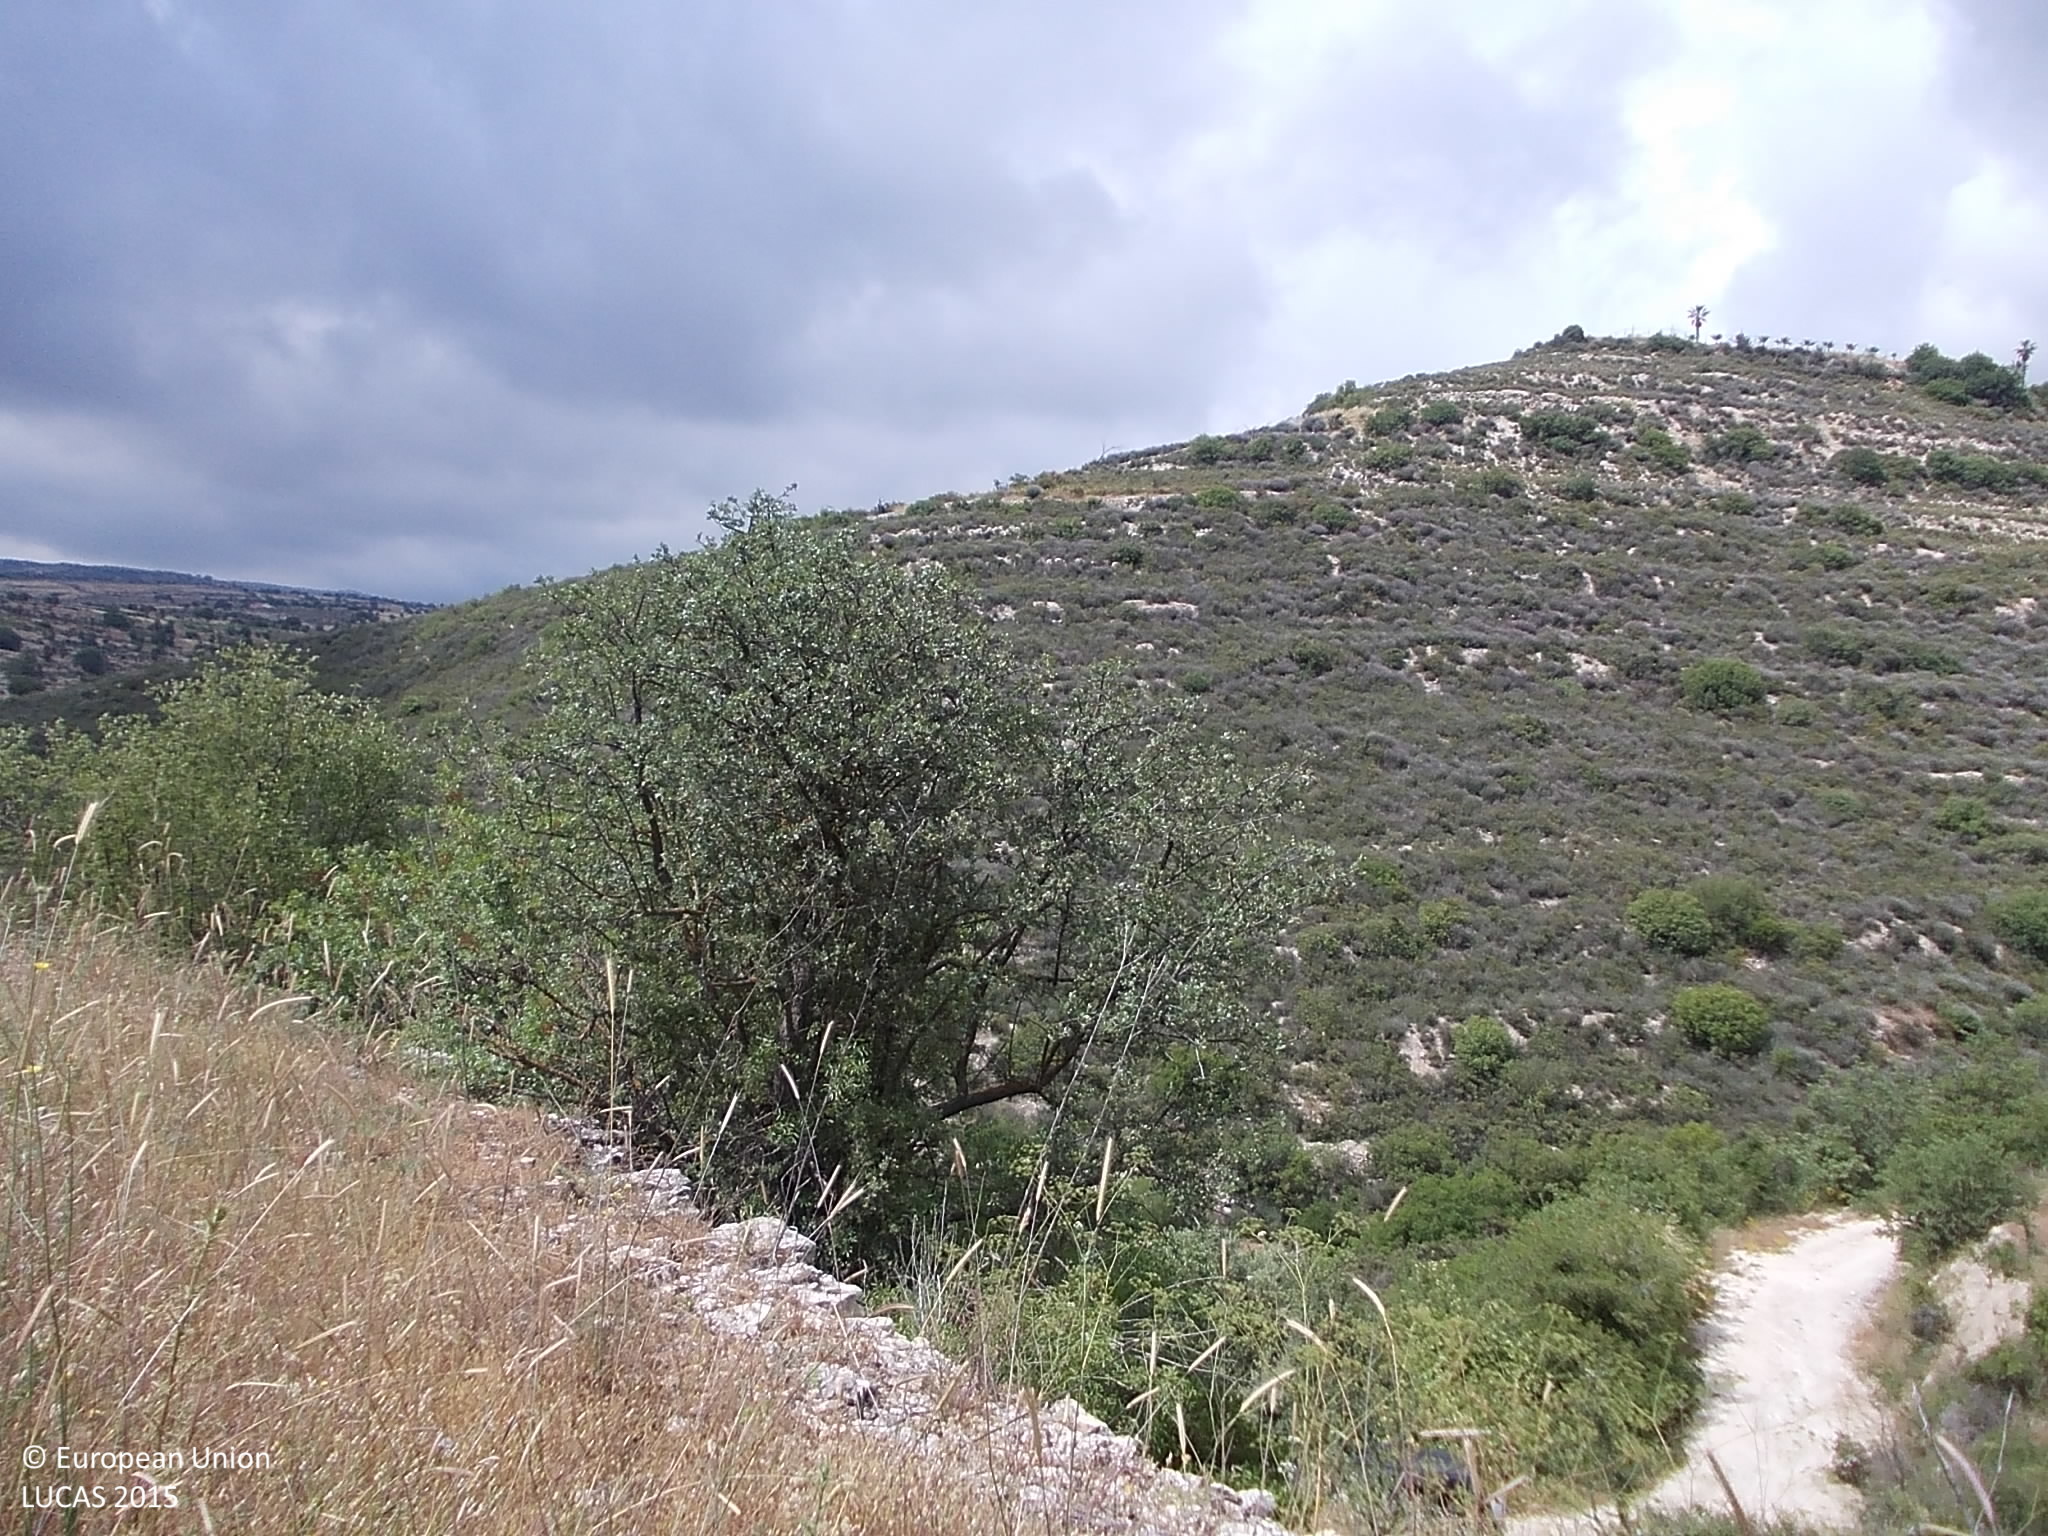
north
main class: Grassland
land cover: Grassland with sparse tree/shrub cover
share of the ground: > 75 %
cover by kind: herbaceous plants 85 %, broadleaved forest trees 5 %, shrubs 5 %, unconsolidated bare surface 5 %
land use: Abandoned areas
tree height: < 5 m
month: May
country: CY
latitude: 34.8078
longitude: 32.7983
